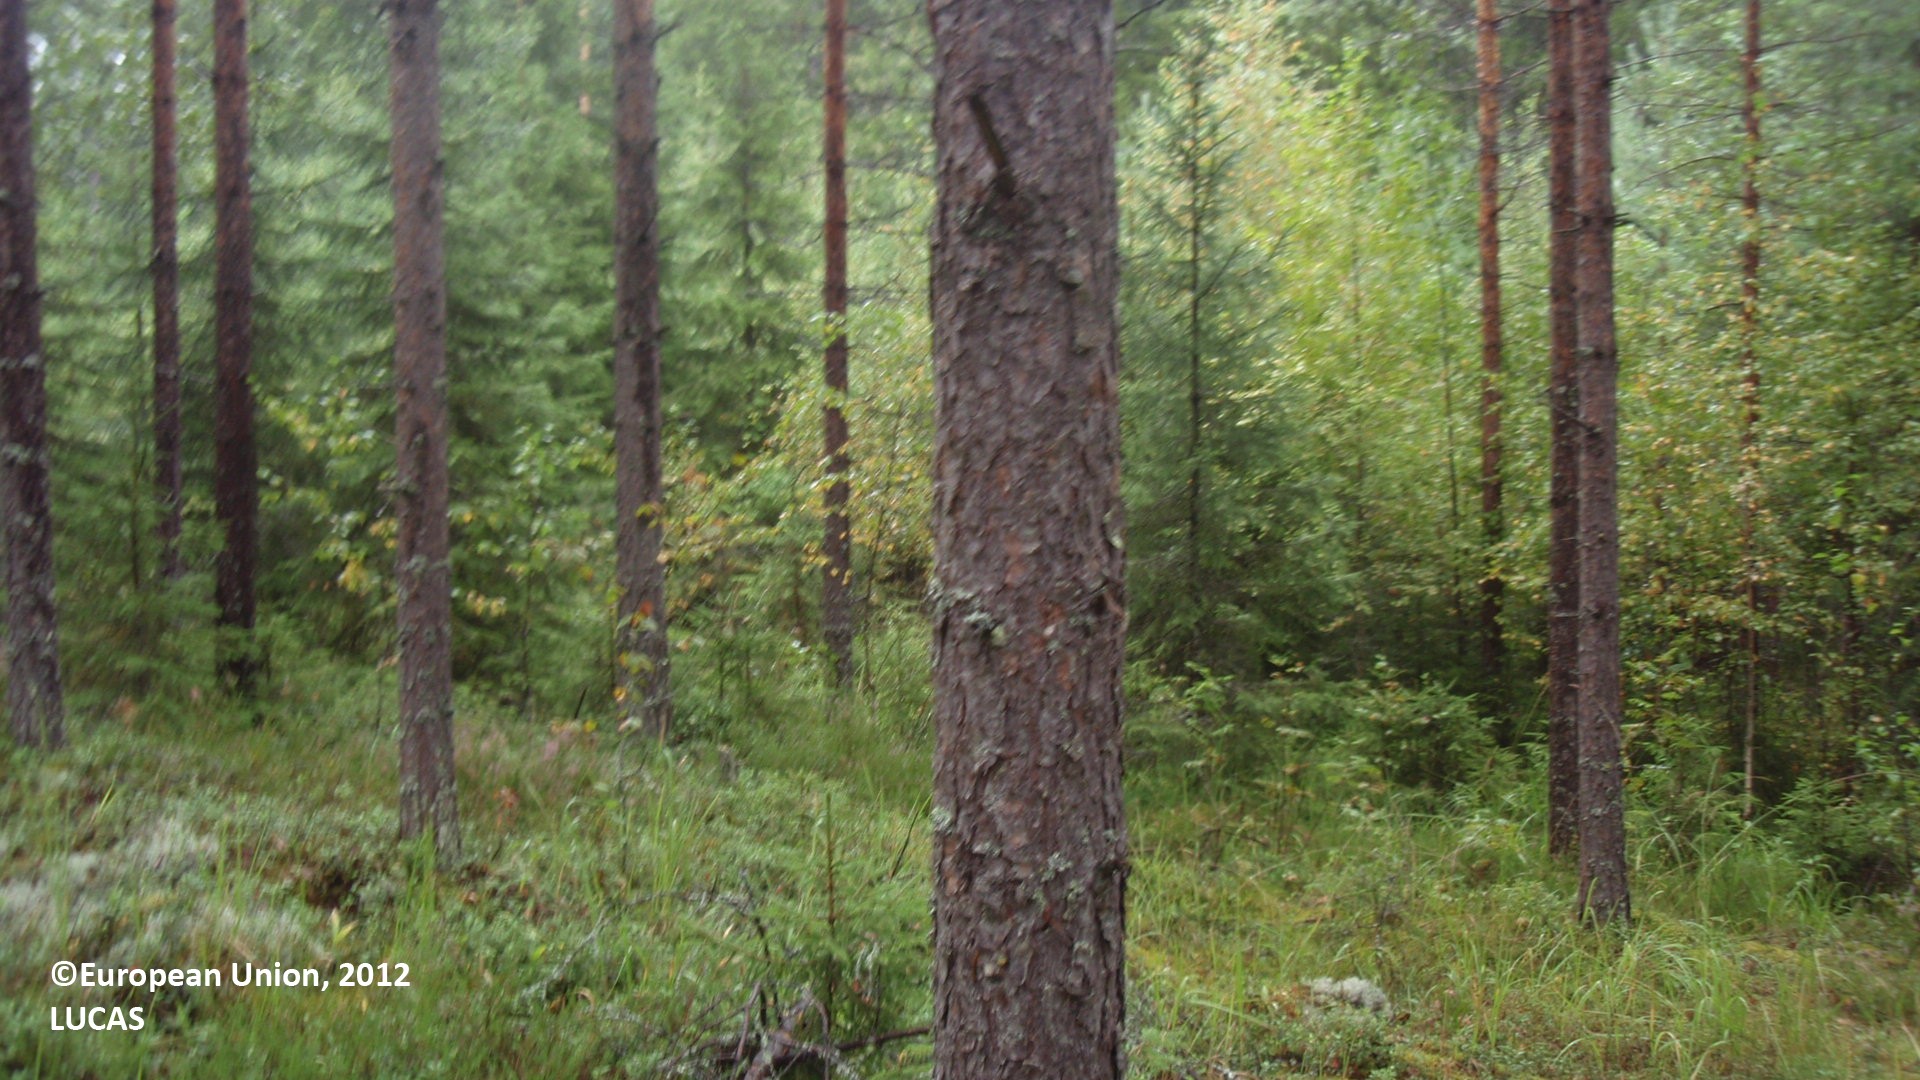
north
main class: Woodland
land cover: Pine dominated coniferous woodland
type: boreal forest
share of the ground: 50 - 75 %
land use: Forestry
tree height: > 5 m
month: August
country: FI
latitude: 61.2458
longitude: 26.8377
